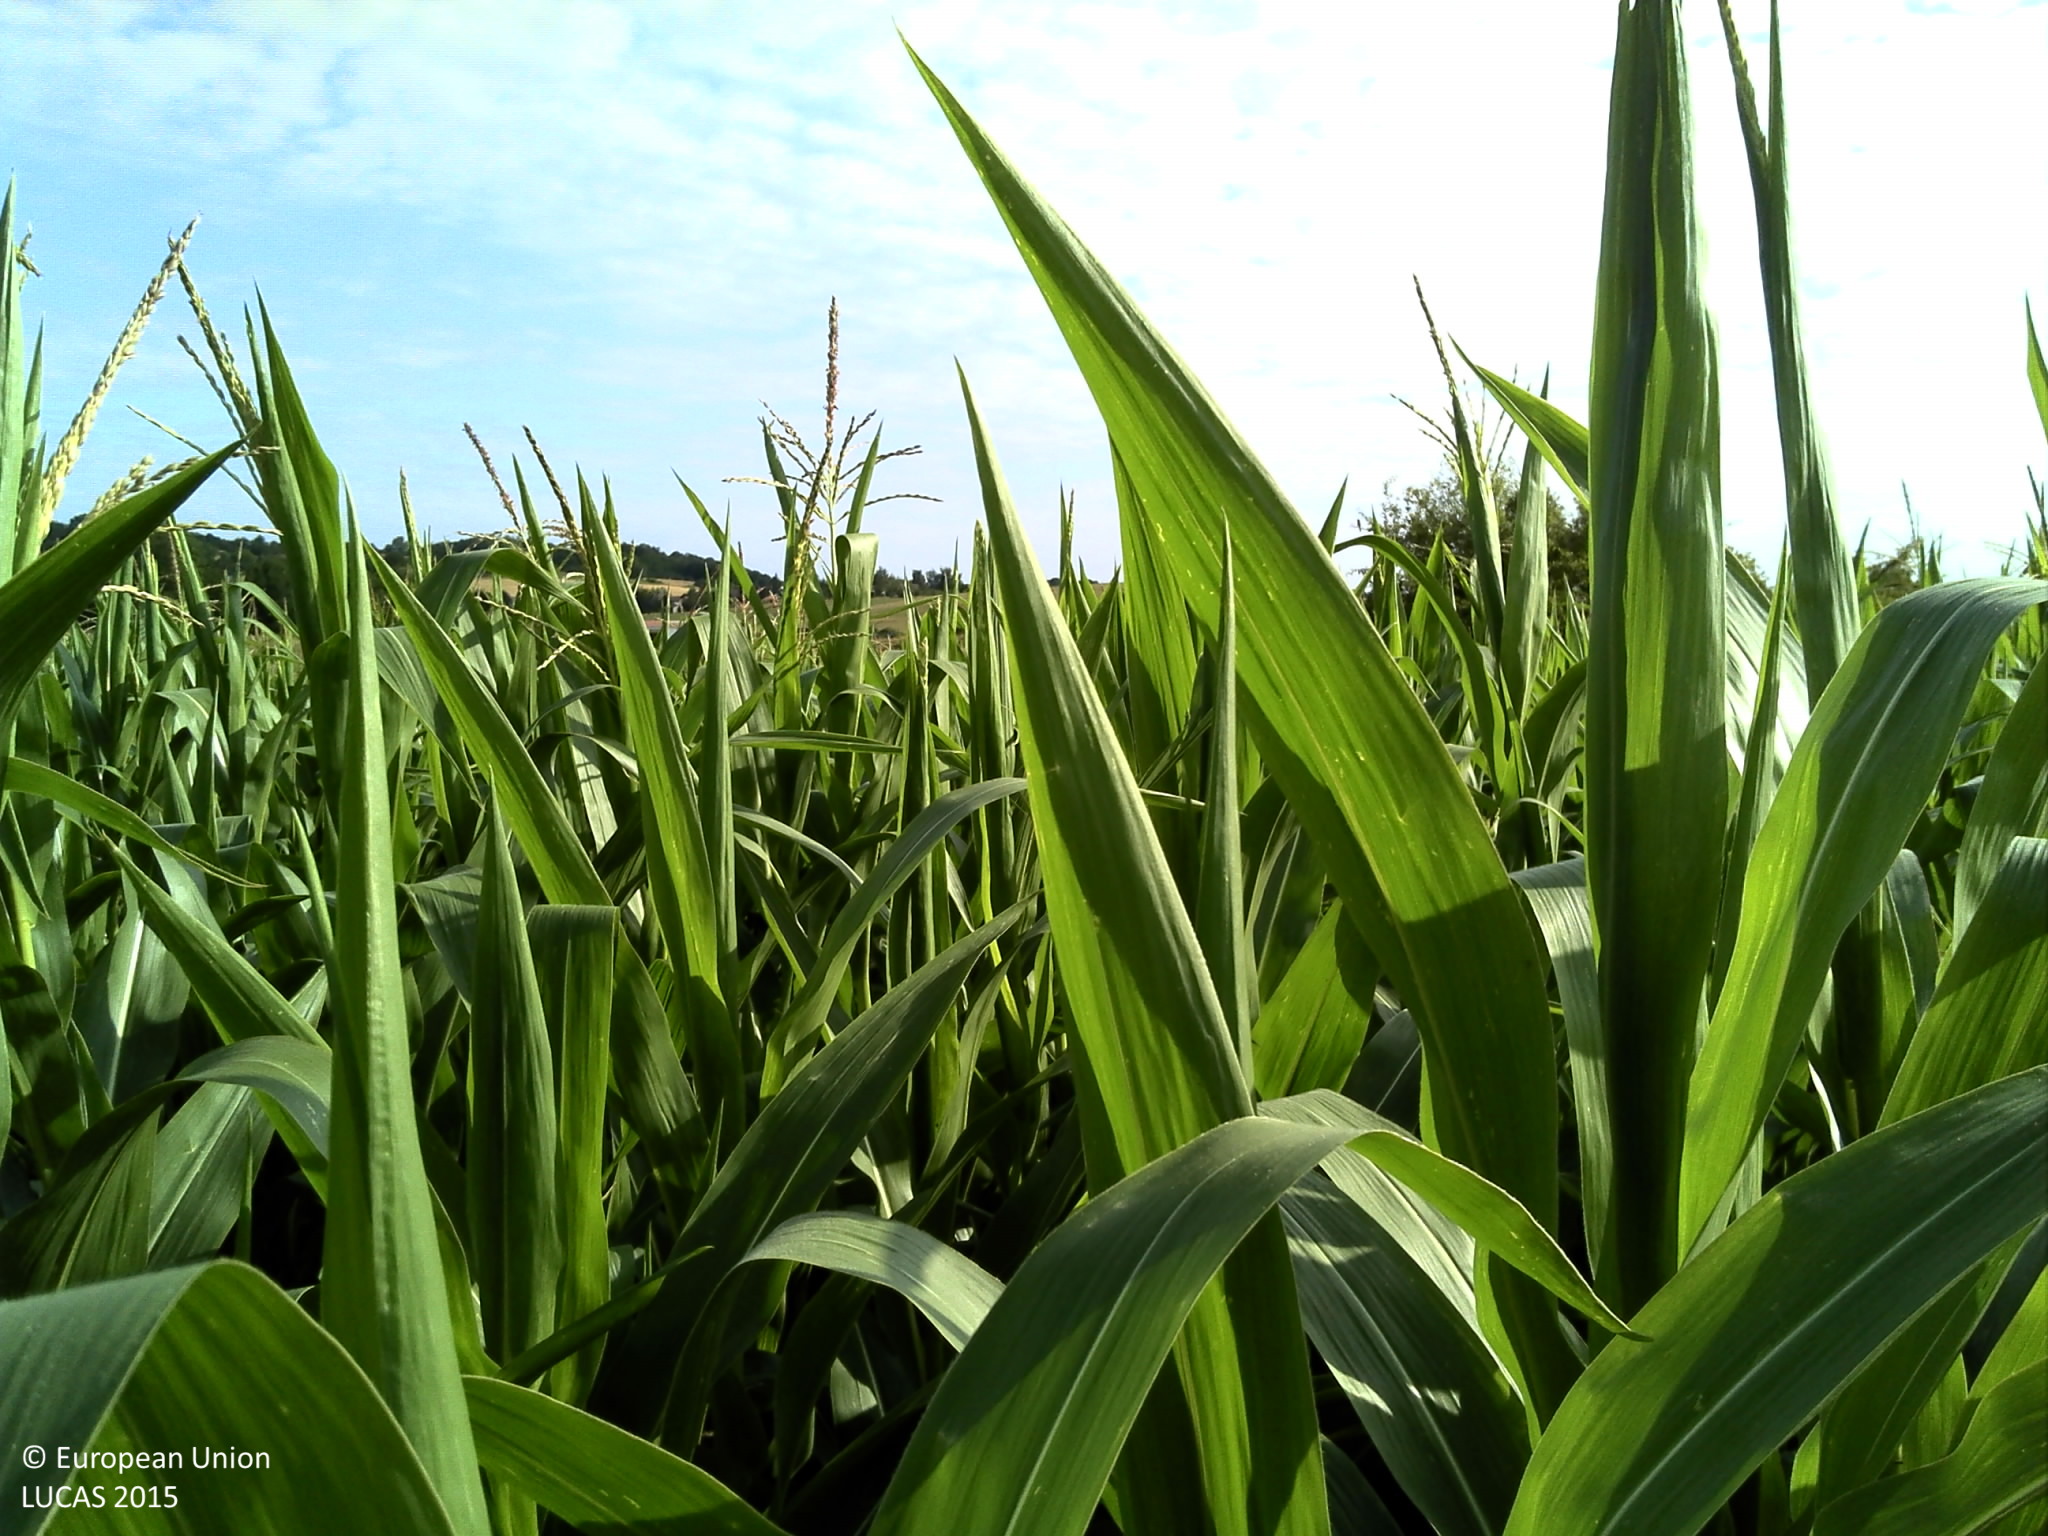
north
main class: Cropland
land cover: Maize
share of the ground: > 75 %
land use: Agriculture (excluding fallow land and kitchen gardens)
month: July
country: FR
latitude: 48.3583
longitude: 6.2620
